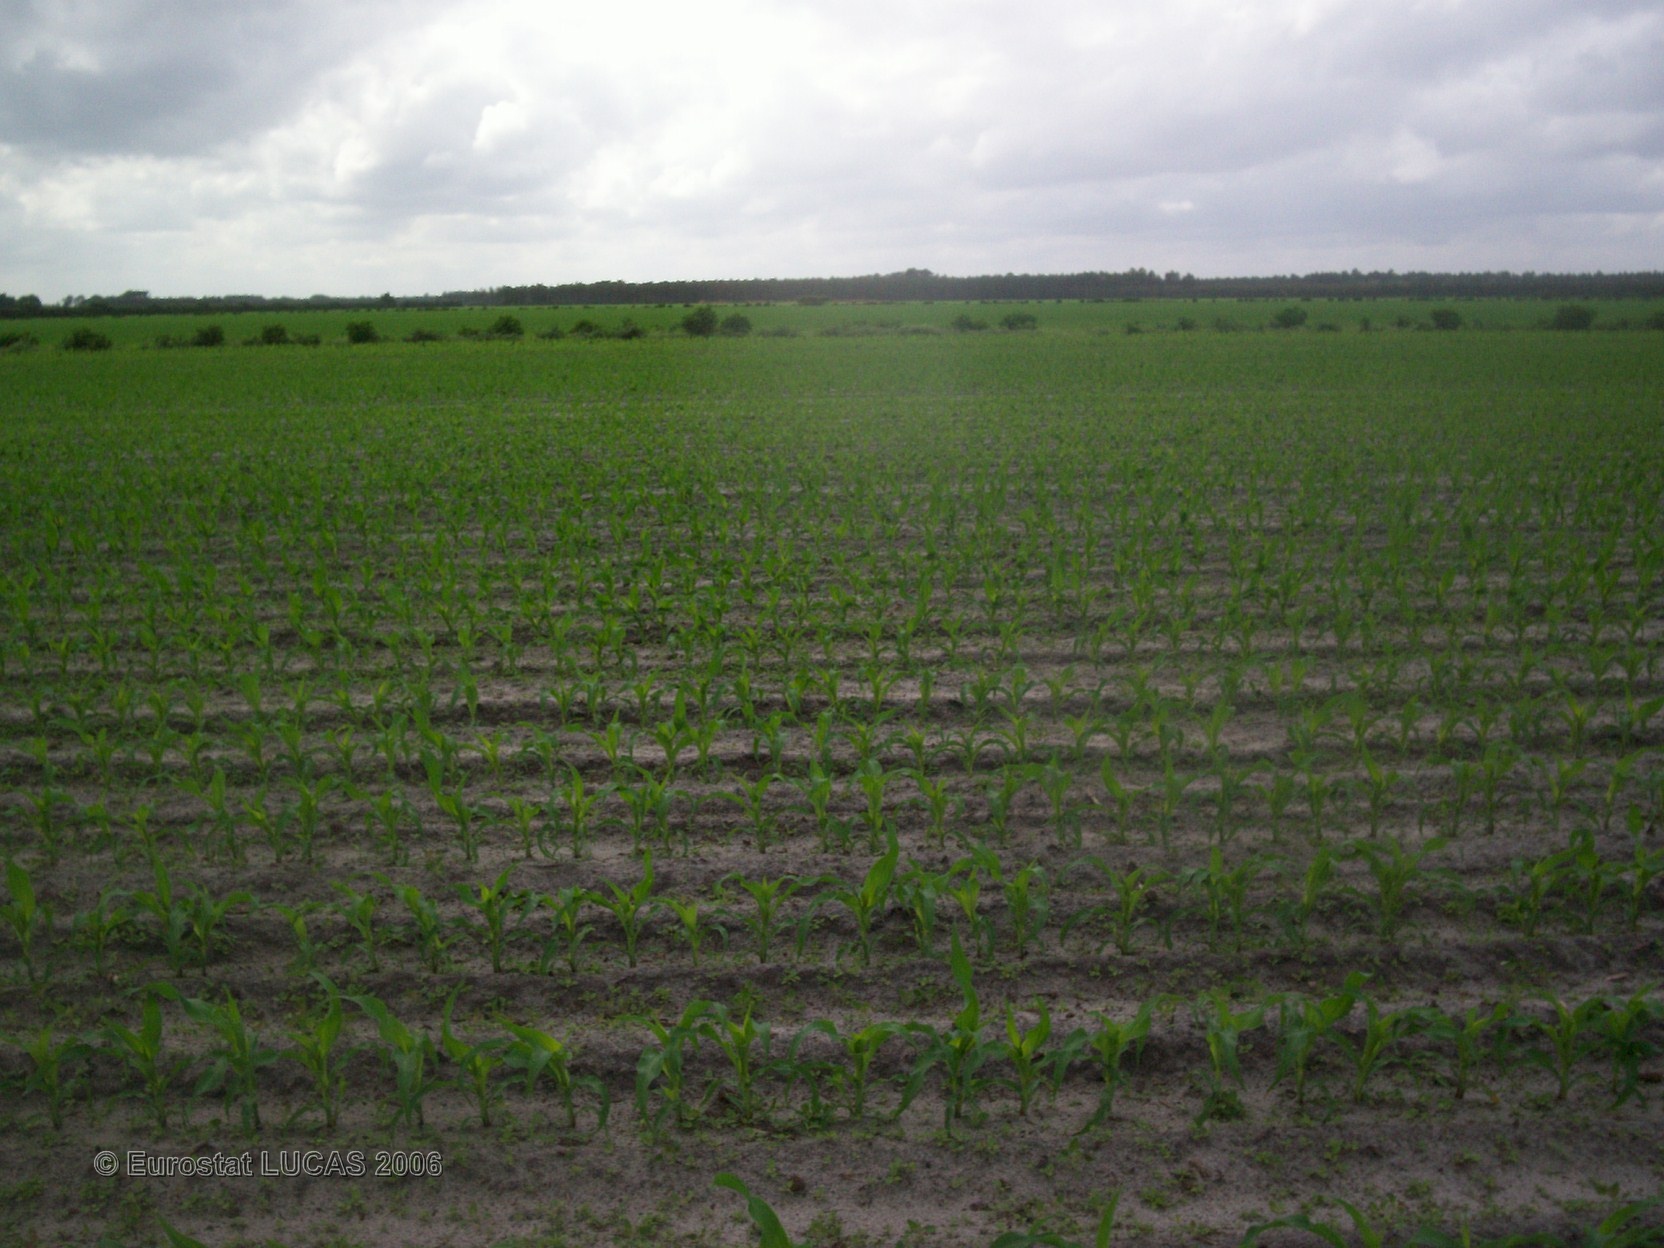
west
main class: Cropland
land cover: Maize
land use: Agriculture (excluding fallow land and kitchen gardens)
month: May
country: FR
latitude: 44.3803
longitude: -0.4953
